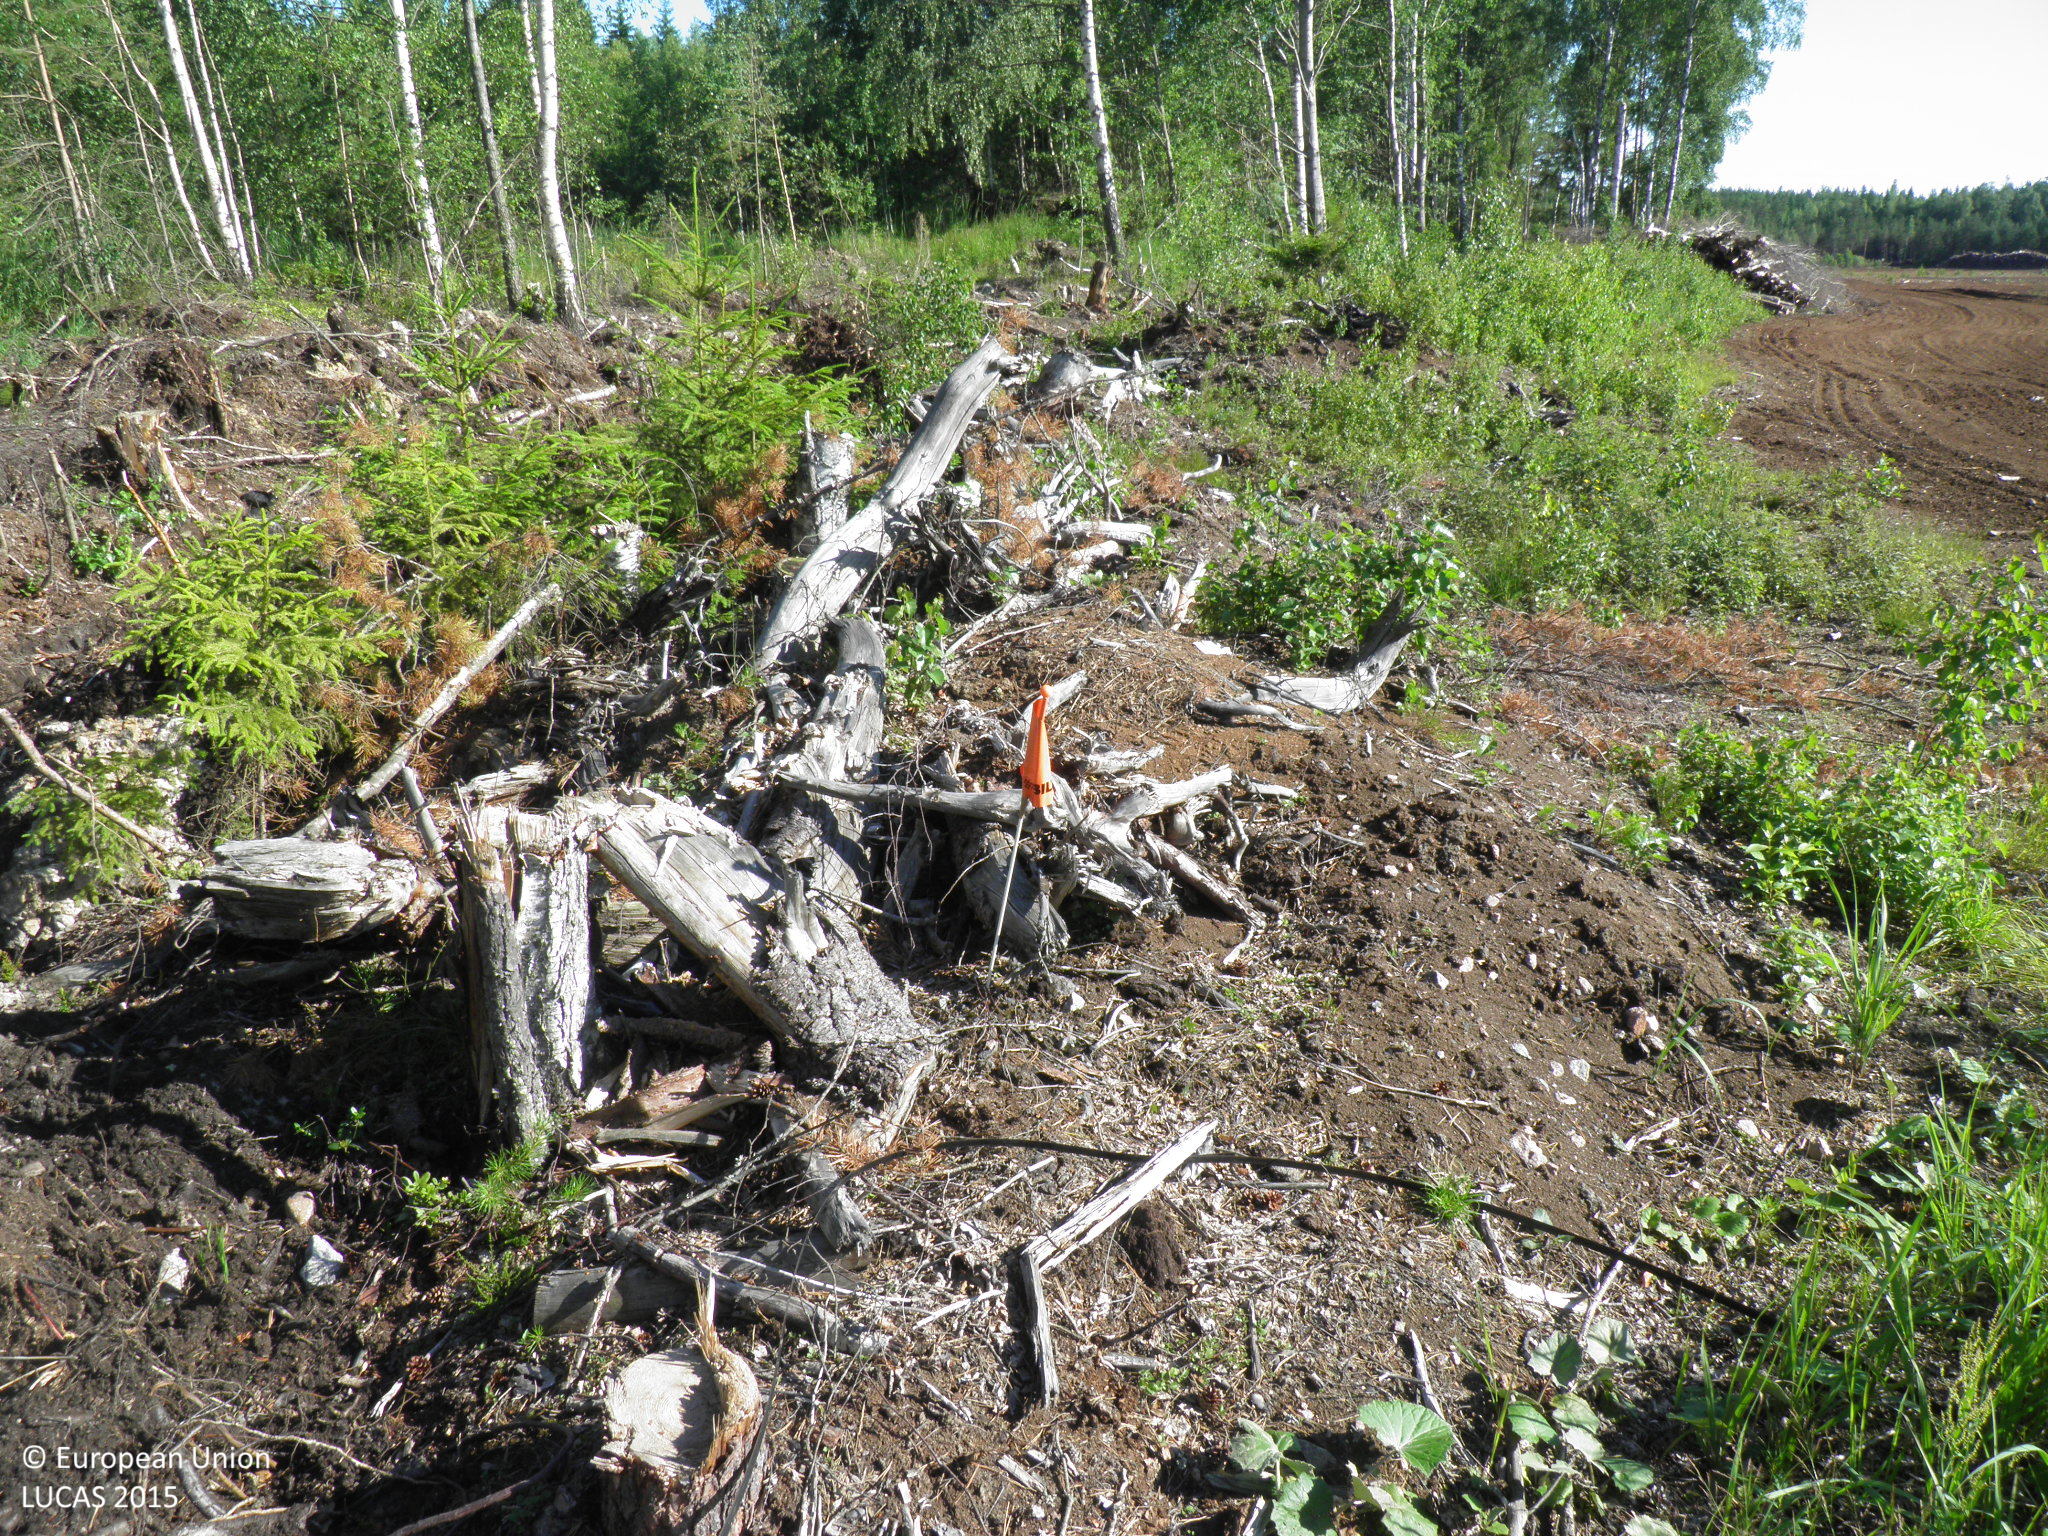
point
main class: Grassland
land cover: Spontaneously vegetated surfaces
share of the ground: 10 - 25 %
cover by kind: unconsolidated bare surface 80 %, herbaceous plants 15 %, shrubs 5 %
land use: Forestry
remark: Clear cut
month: July
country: FI
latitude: 60.5465
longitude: 22.7817
